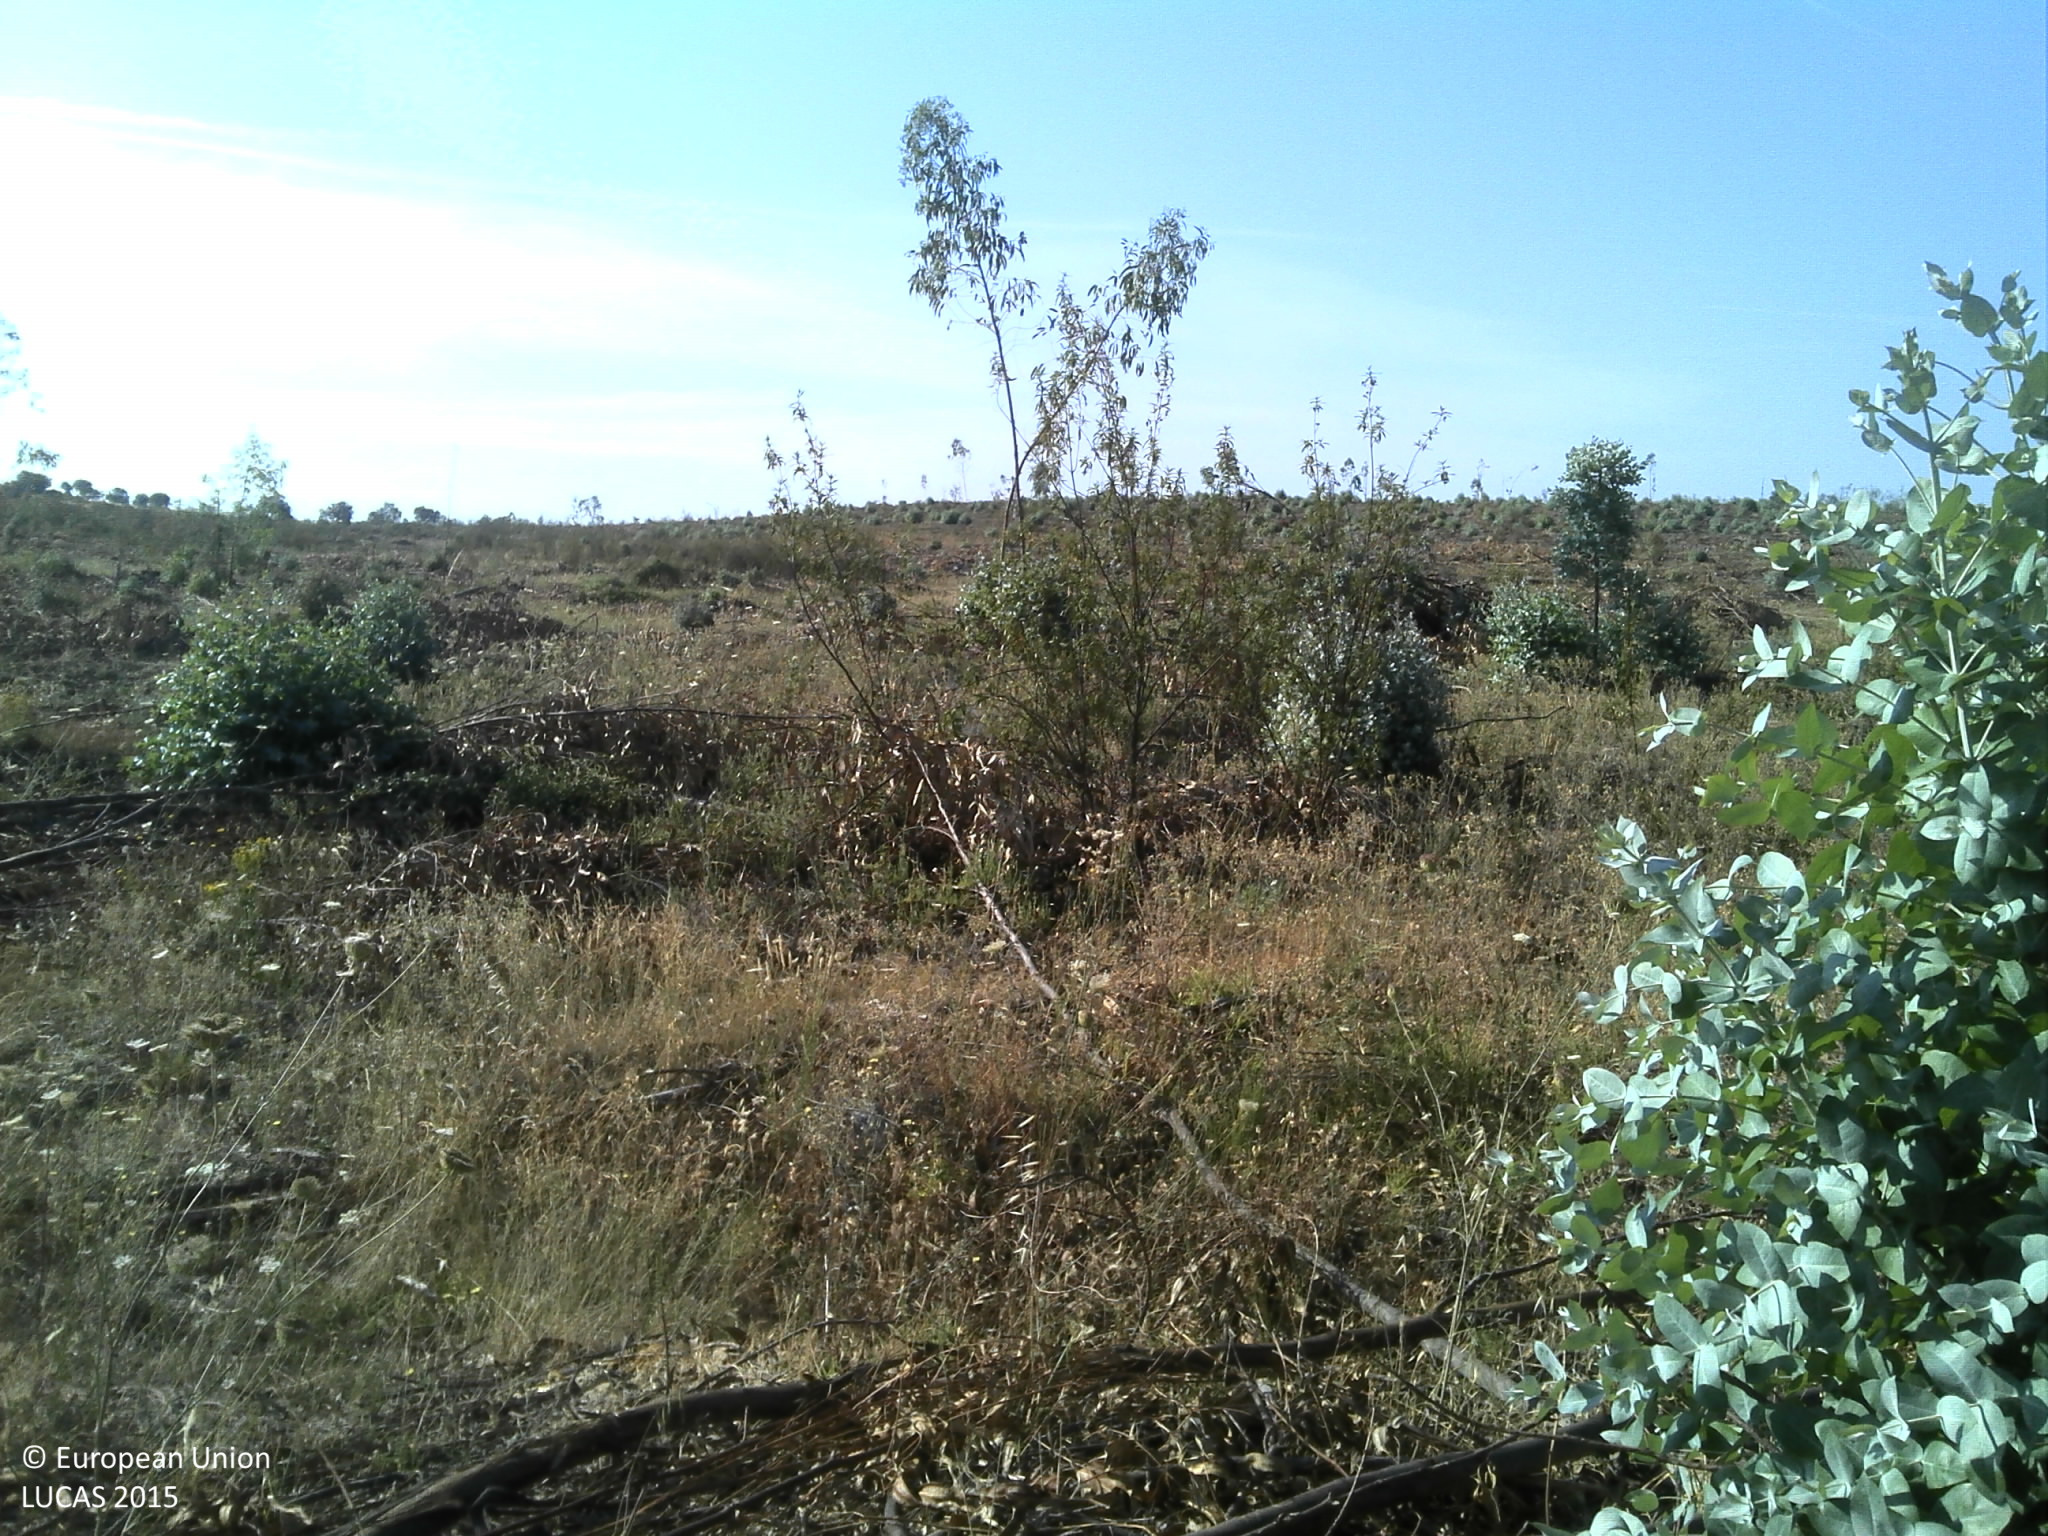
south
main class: Woodland
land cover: Broadleaved woodland
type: exotic forest
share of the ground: 25 - 50 %
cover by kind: unconsolidated bare surface 65 %, broadleaved forest trees 25 %, shrubs 10 %
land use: Forestry
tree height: < 5 m
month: June
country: PT
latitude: 39.9267
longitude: -7.1405
